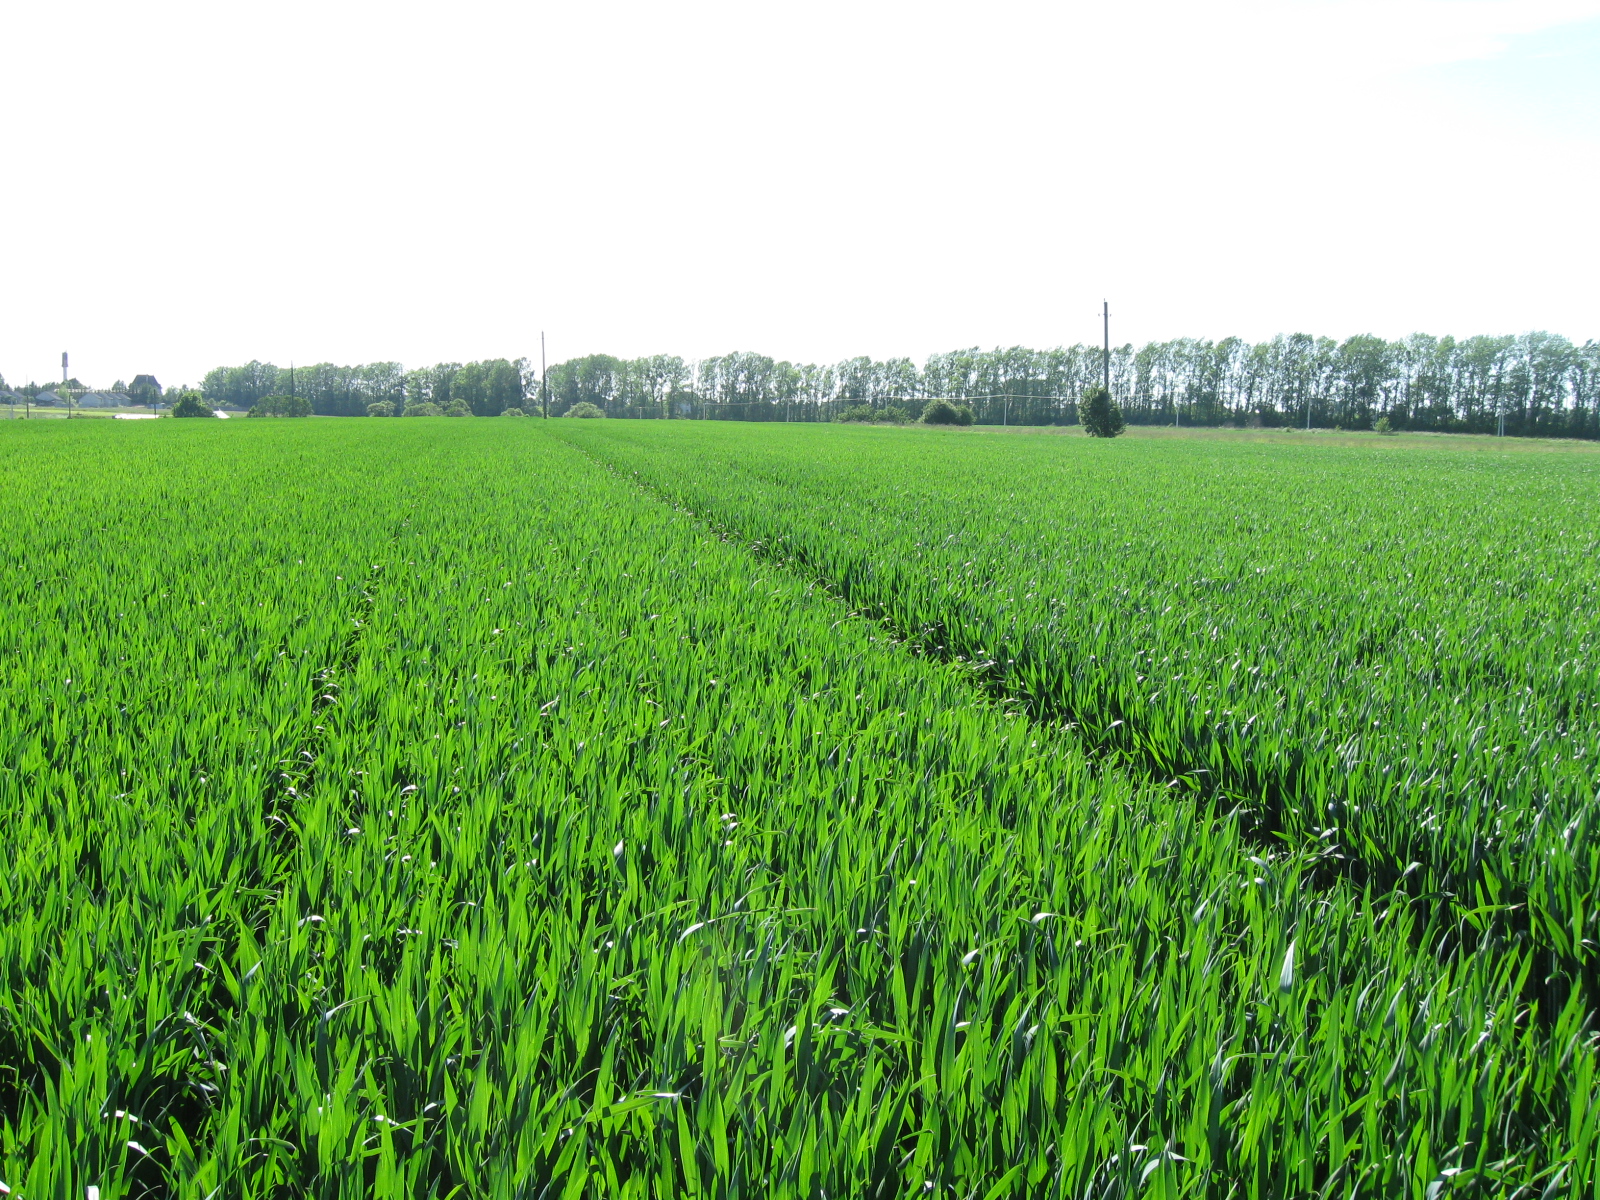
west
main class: Cropland
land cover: Common wheat
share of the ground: > 75 %
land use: Agriculture (excluding fallow land and kitchen gardens)
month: June
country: LT
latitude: 54.8344
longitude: 23.9623
